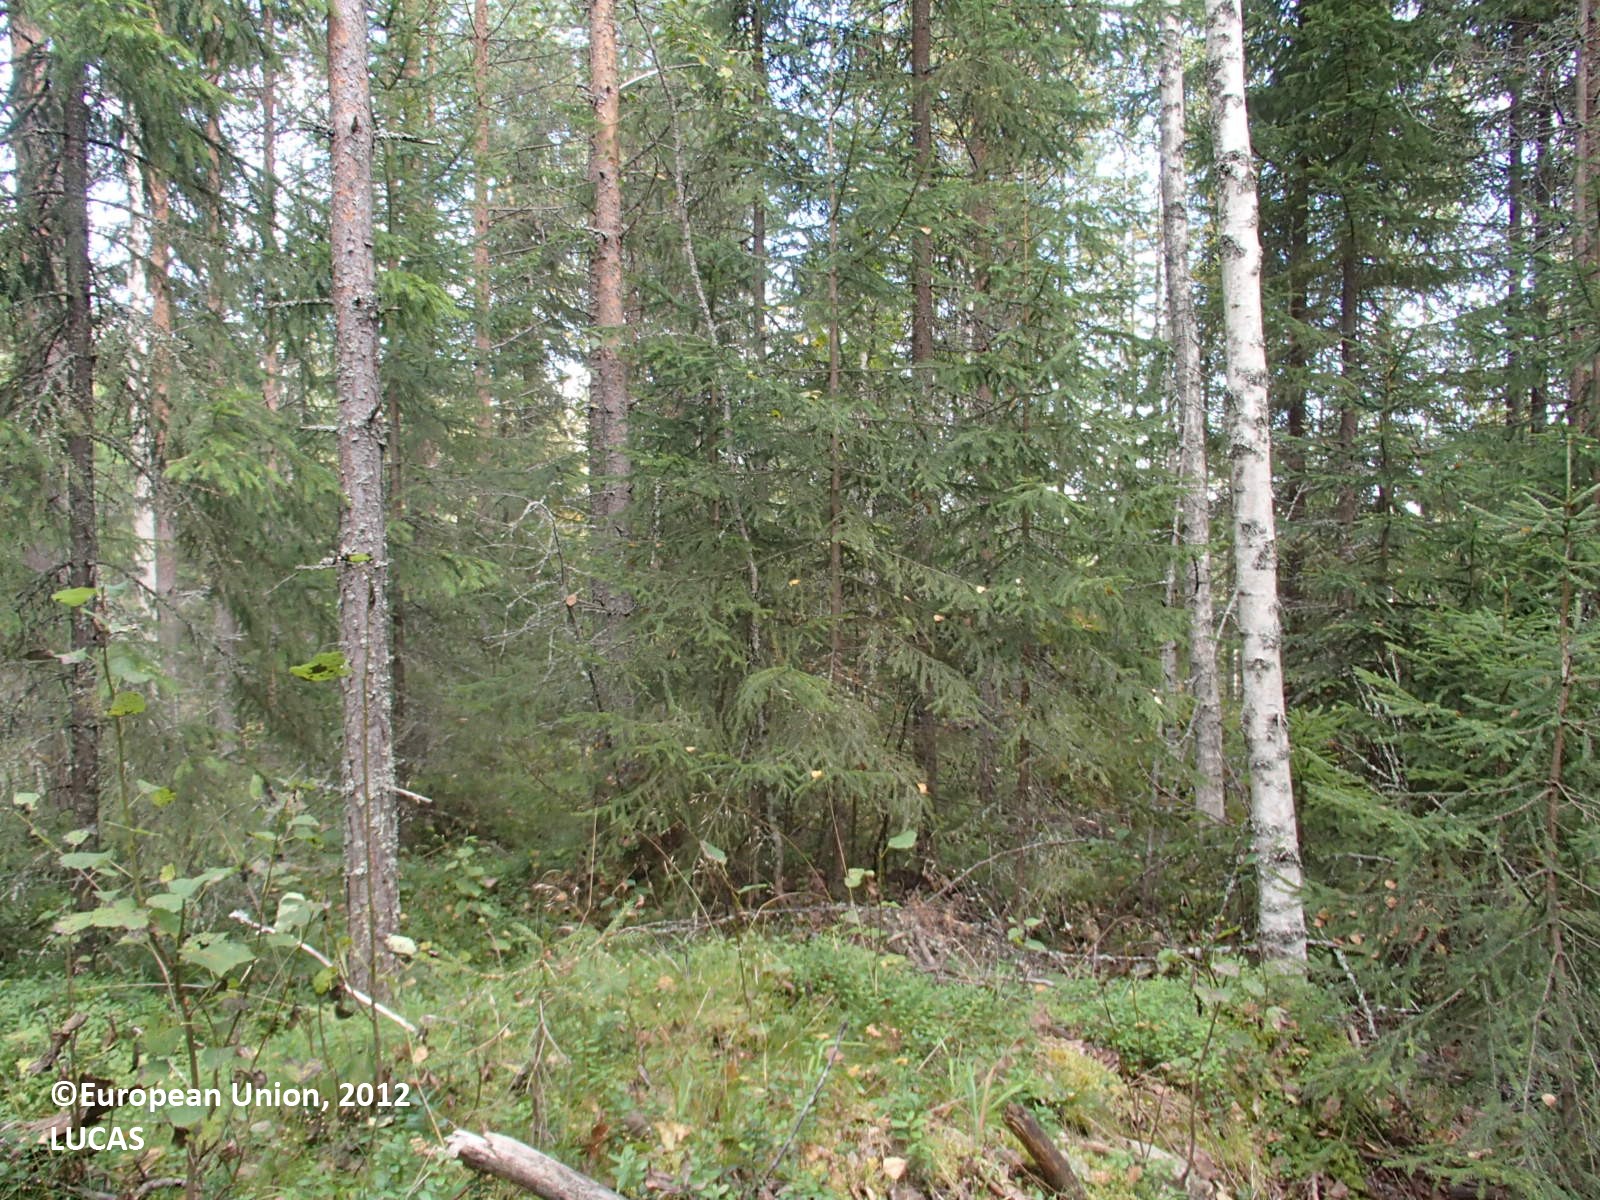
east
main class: Woodland
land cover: Other coniferous woodland
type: boreal forest
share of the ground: > 75 %
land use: Forestry
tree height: > 5 m
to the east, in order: Other coniferous woodland; Pine dominated mixed woodland; Ditches and canals; Pine dominated mixed woodland; Ditches and canals; Pine dominated mixed woodland; Ditches and canals; Pine dominated mixed woodland; Ditches and canals; Pine dominated mixed woodland
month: August
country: FI
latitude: 63.6640
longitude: 27.0924
